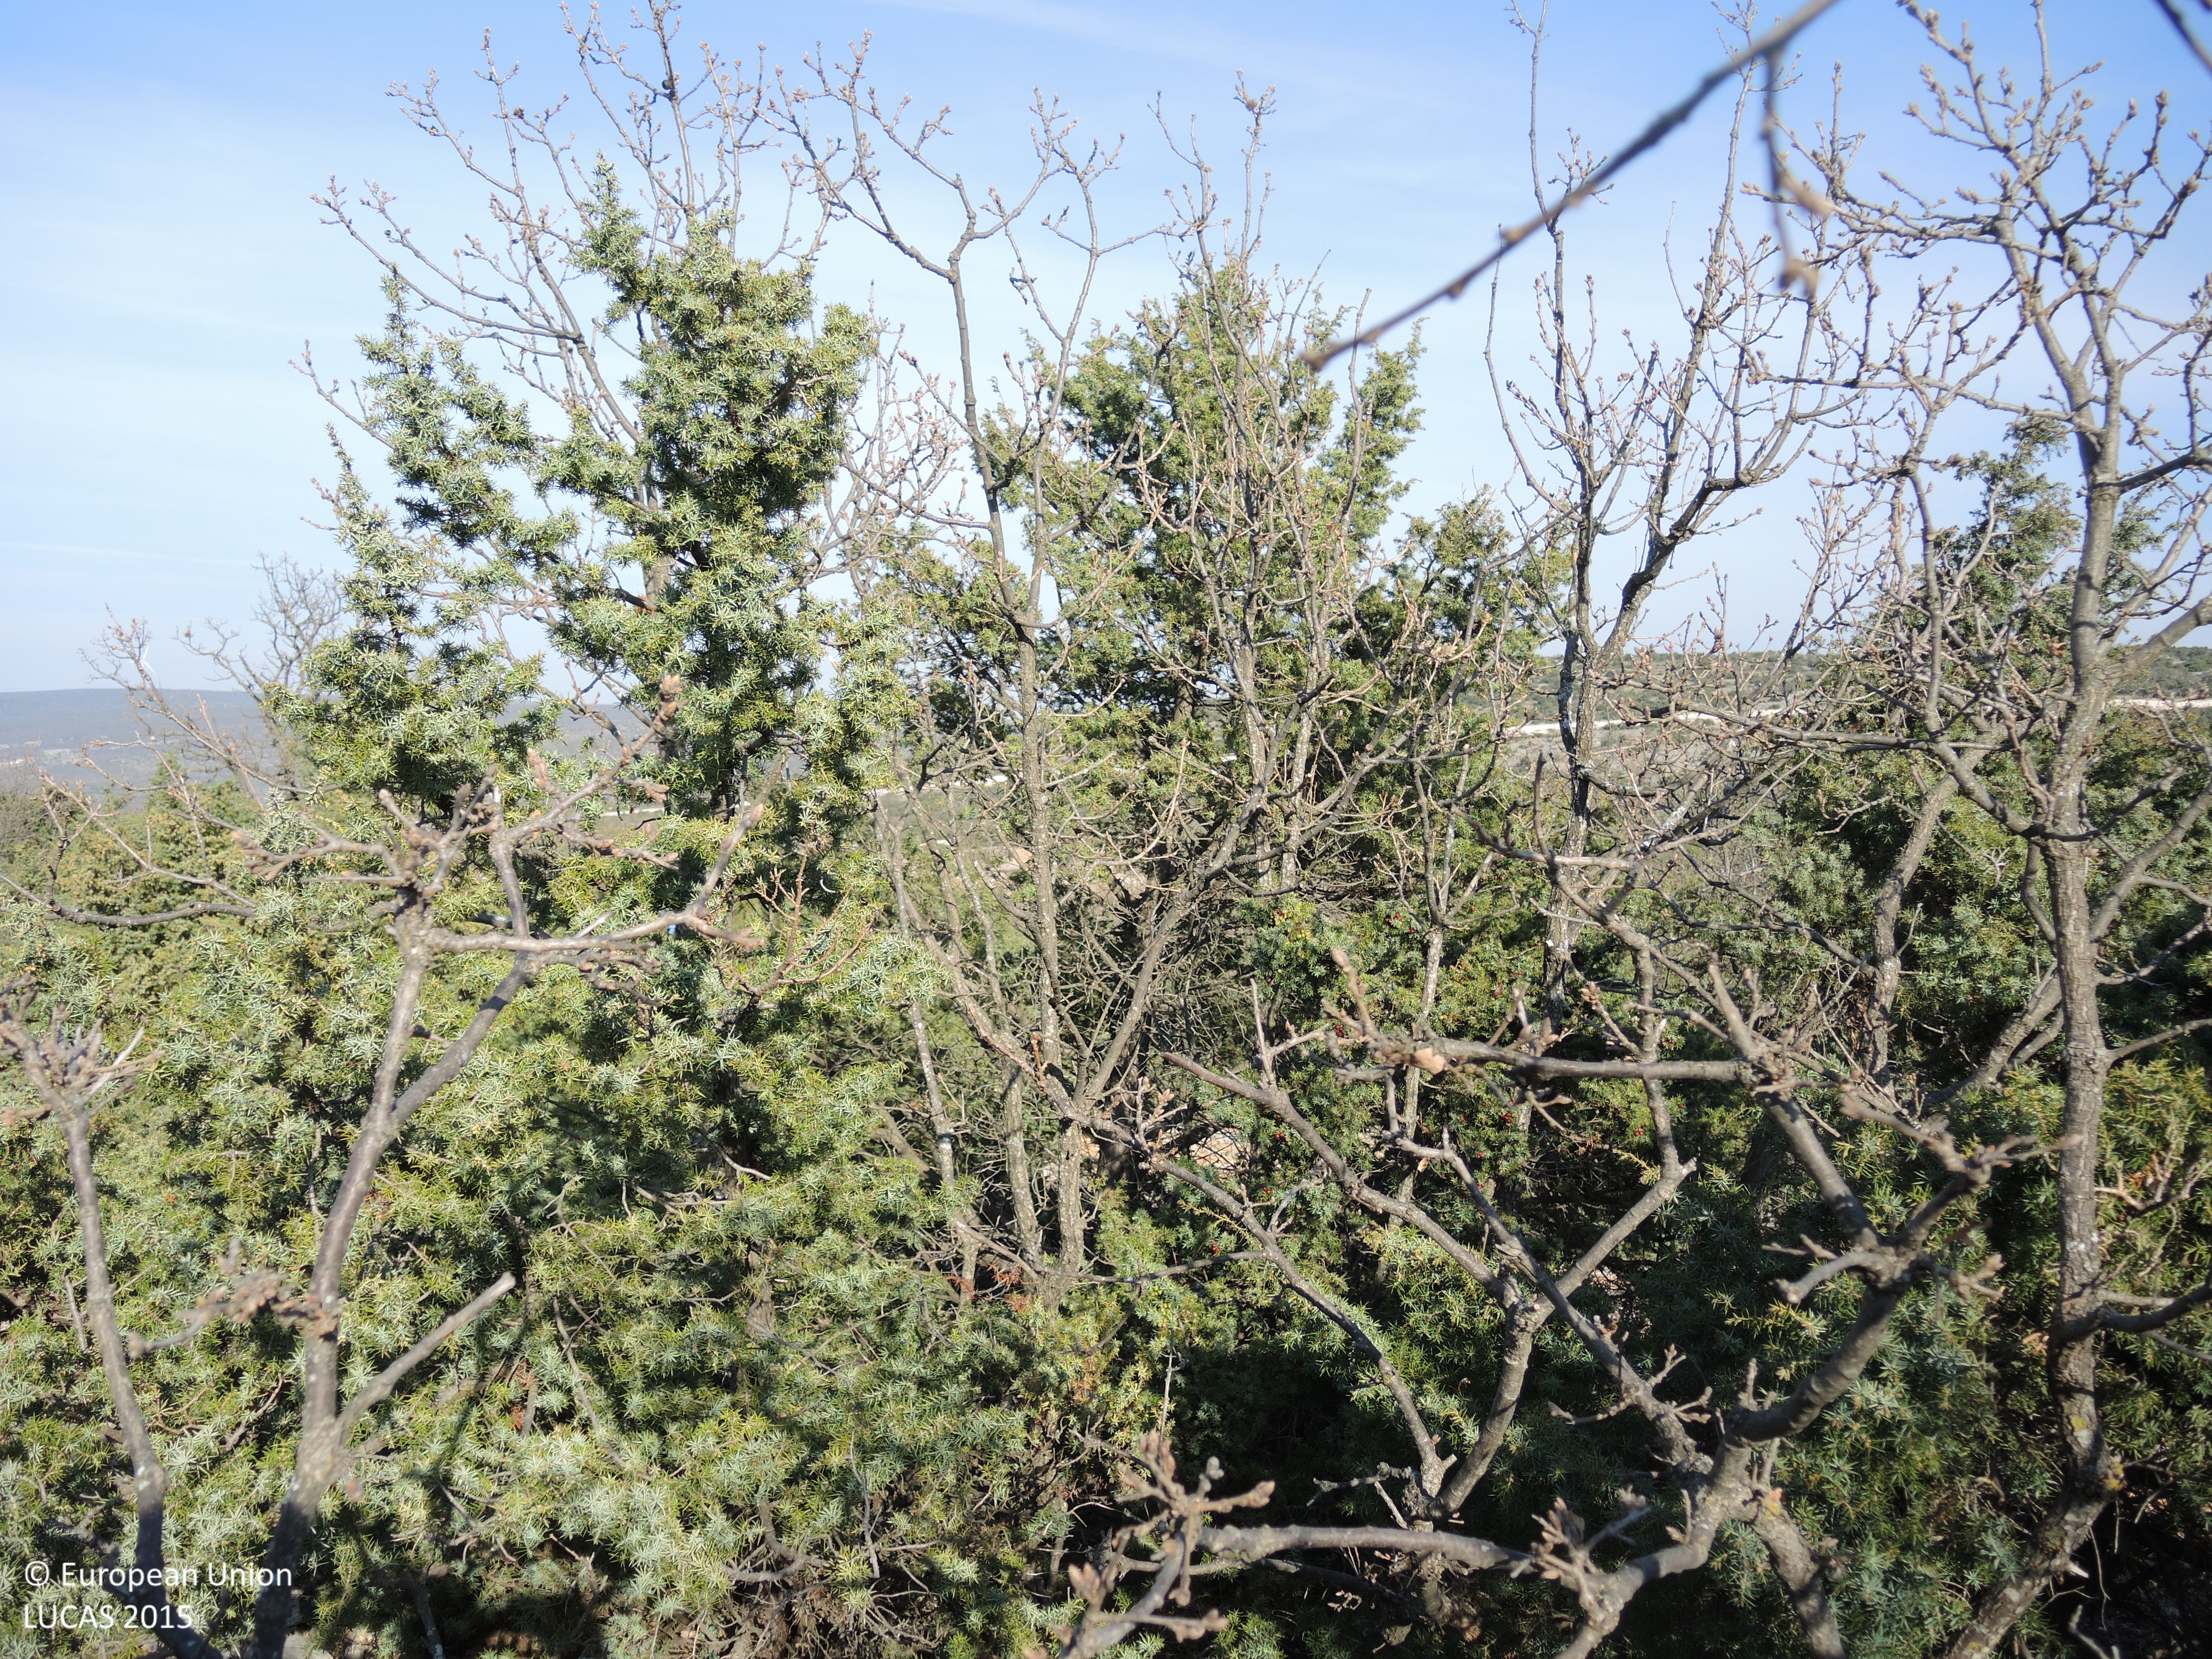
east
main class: Shrubland
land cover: Shrubland with sparse tree cover
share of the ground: 25 - 50 %
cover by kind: unconsolidated bare surface 35 %, shrubs 30 %, herbaceous plants 20 %, consolidated bare surface 10 %, broadleaved forest trees 5 %
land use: Semi-natural and natural areas not in use
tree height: < 5 m
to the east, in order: Shrubland with sparse tree cover; Tracks; Shrubland without tree cover; Paved roads, cycling and walking lanes; Grassland with sparse tree/shrub cover; Tracks; Shrubland with sparse tree cover; Tracks; Shrubland with sparse tree cover
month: April
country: HR
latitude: 44.0495
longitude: 15.6959
